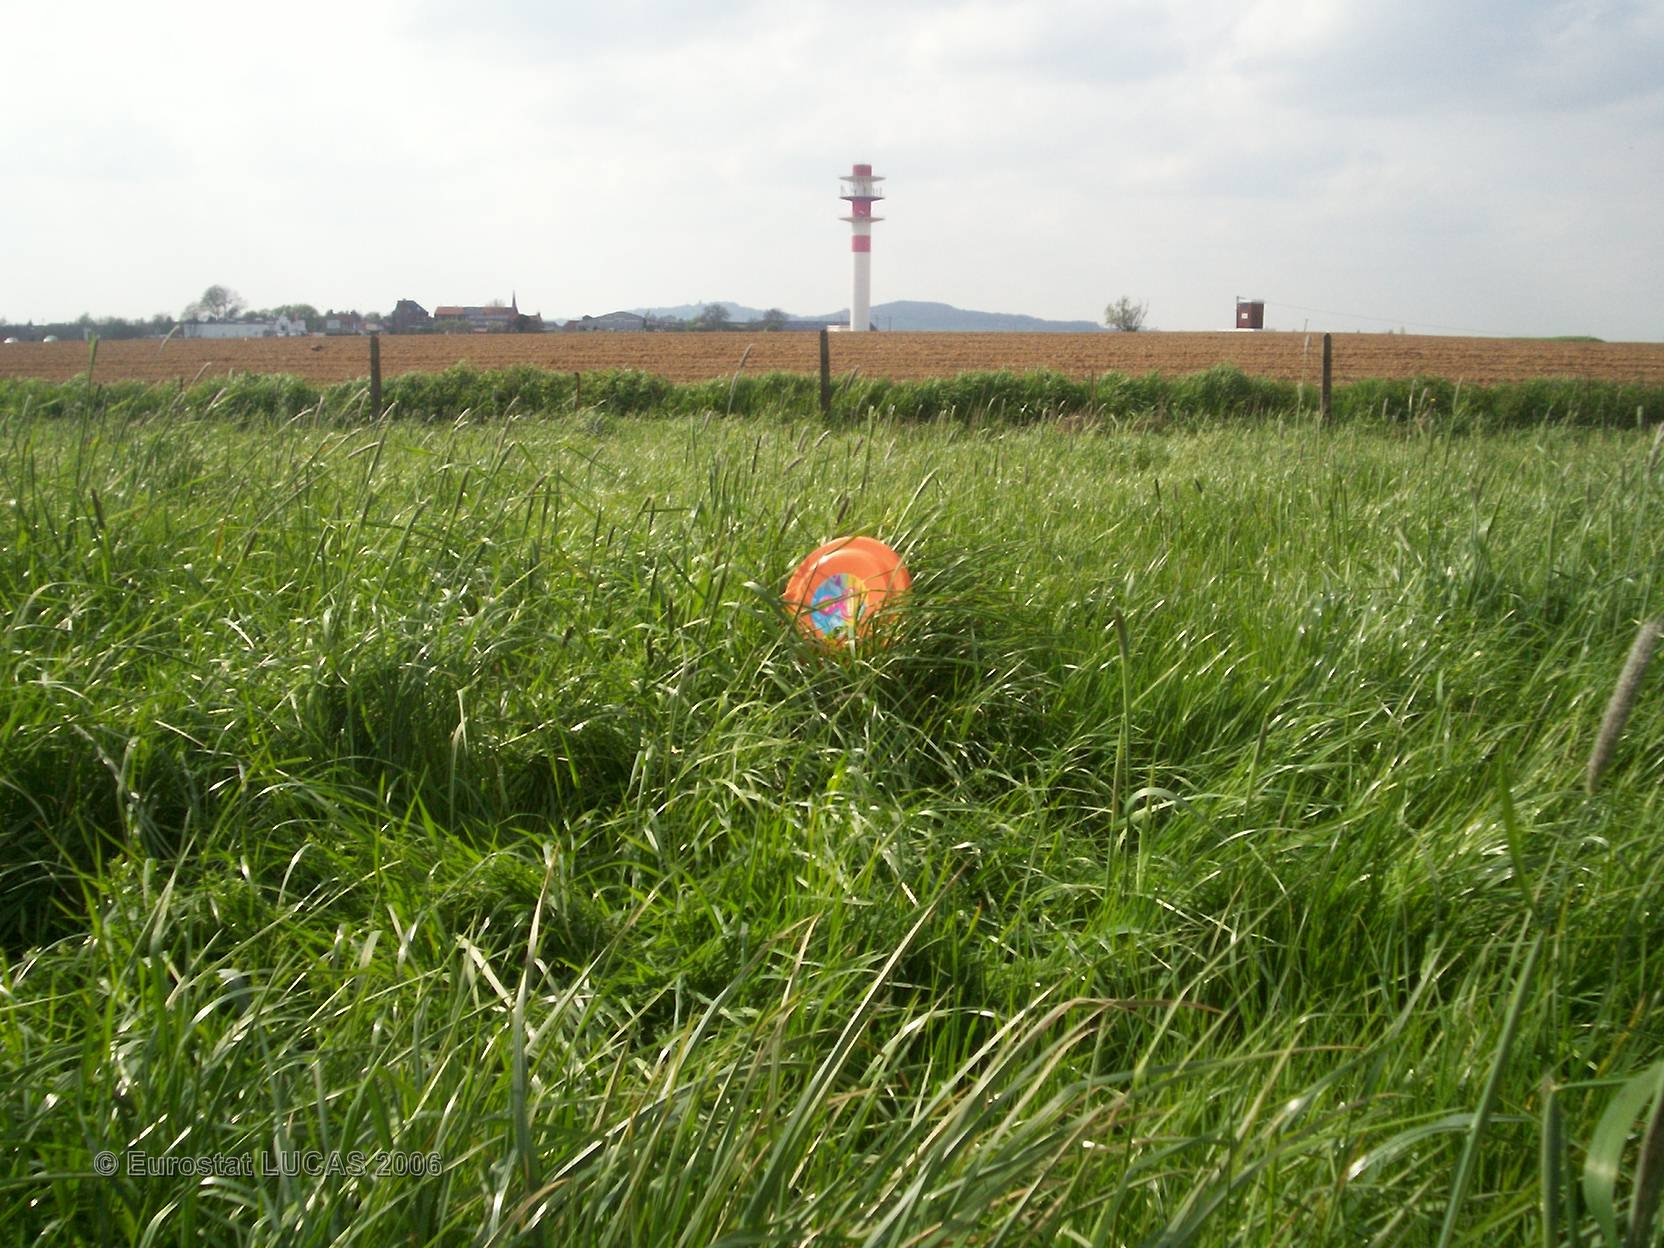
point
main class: Grassland
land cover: Grassland without tree/shrub cover
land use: Agriculture (excluding fallow land and kitchen gardens)
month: May
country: FR
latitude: 50.7724
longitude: 2.5714
